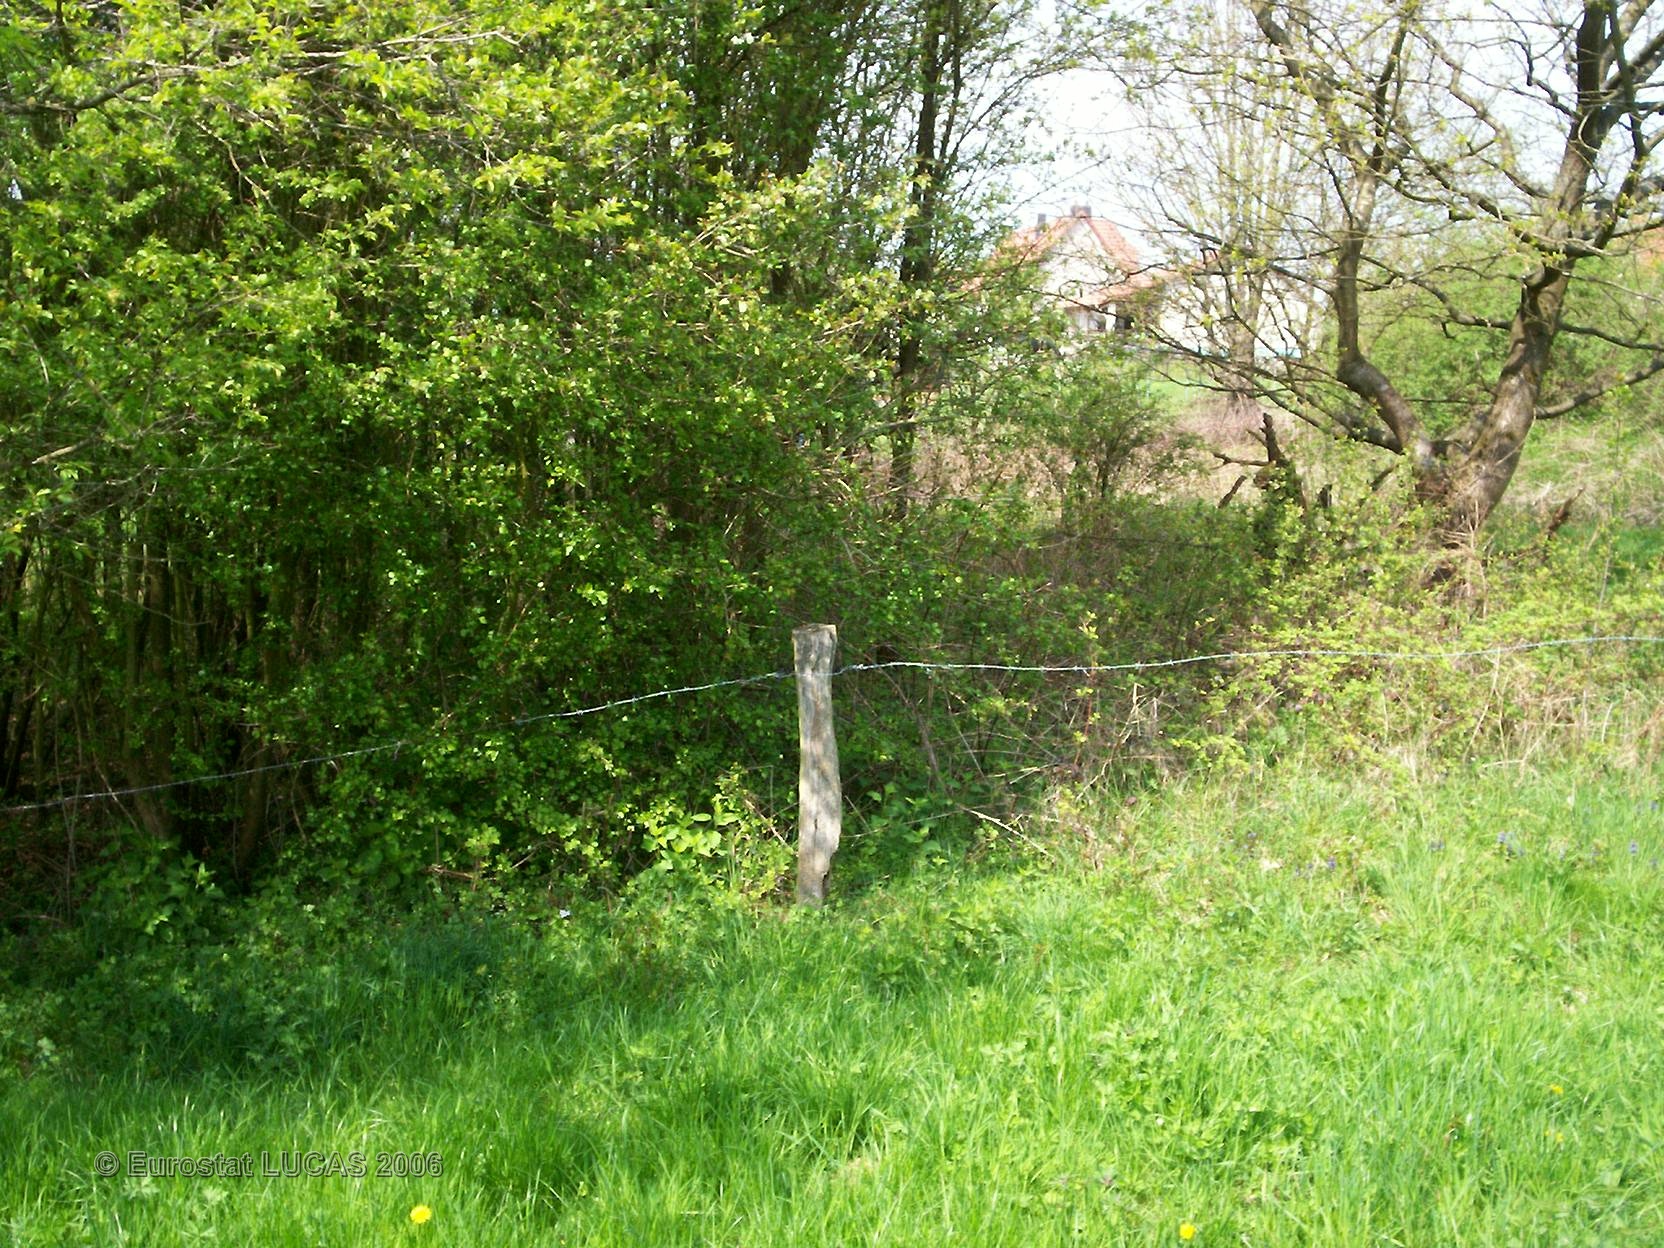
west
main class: Grassland
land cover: Grassland with sparse tree/shrub cover
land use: Agriculture (excluding fallow land and kitchen gardens)
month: May
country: FR
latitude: 49.0740
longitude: 7.3585
